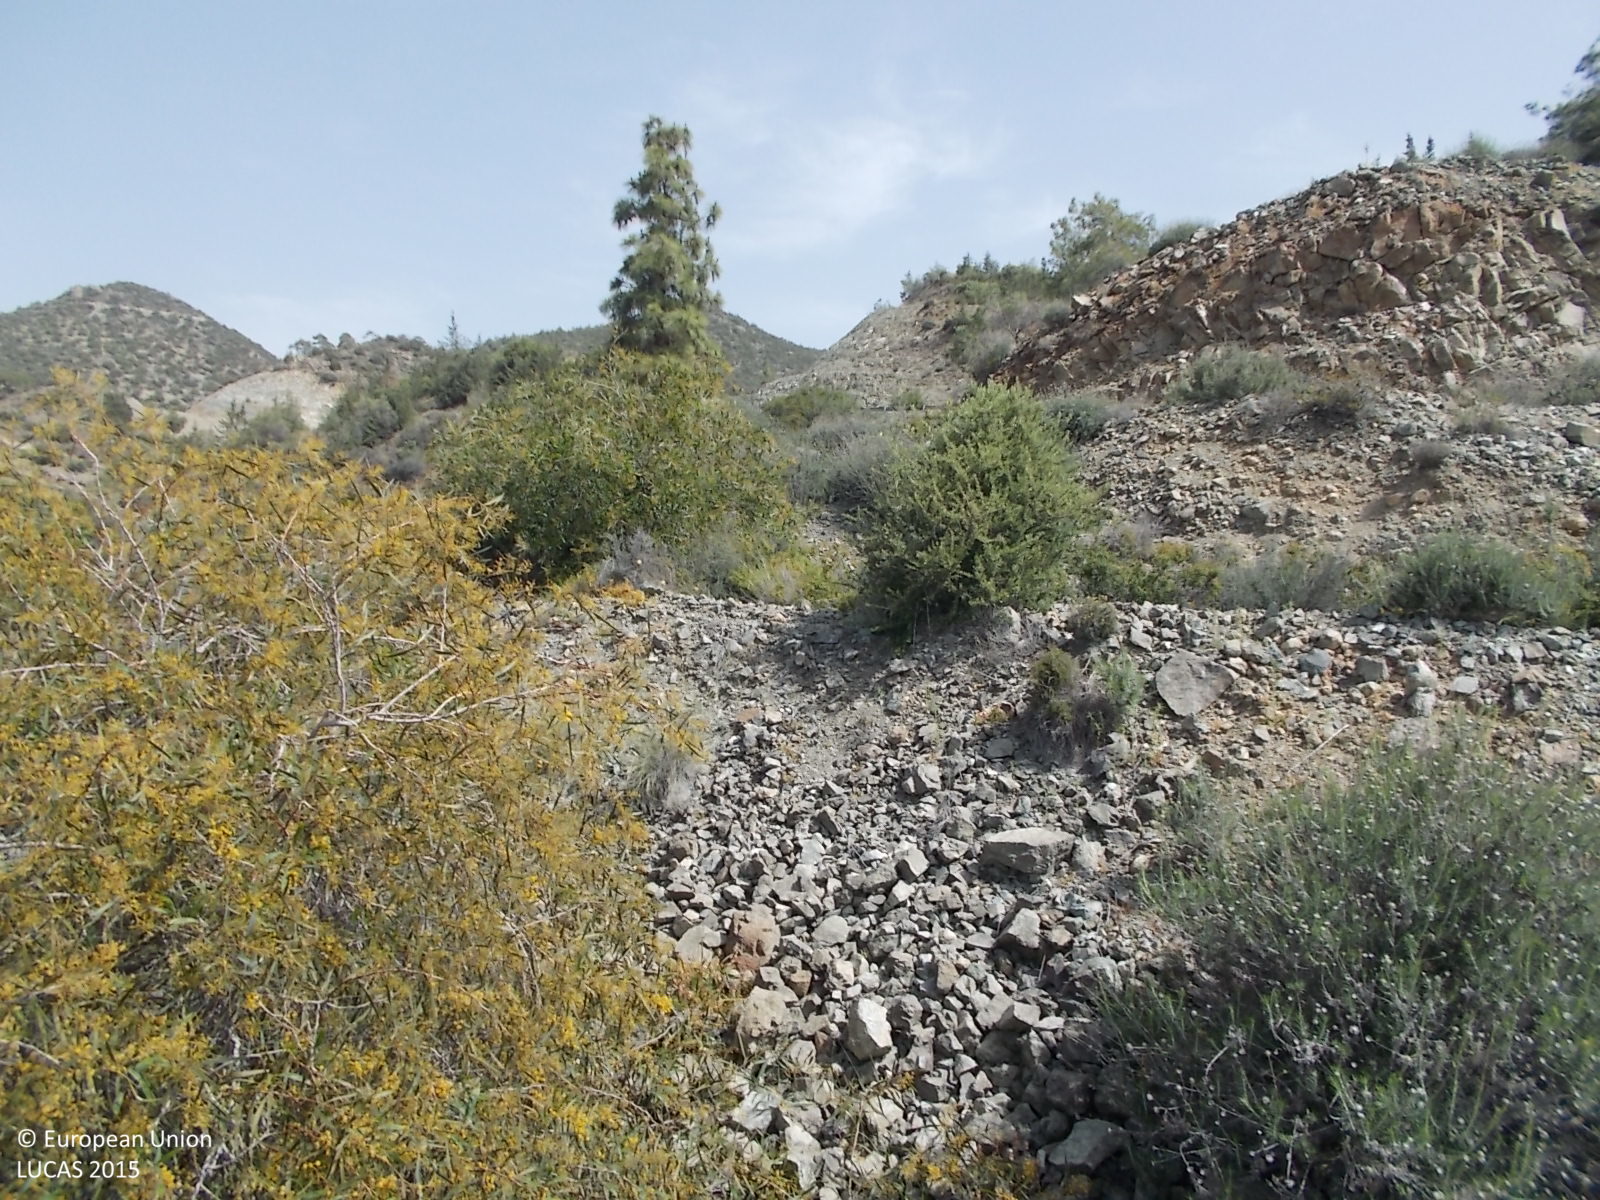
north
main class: Shrubland
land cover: Shrubland with sparse tree cover
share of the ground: > 75 %
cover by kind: shrubs 95 %, coniferous forest trees 5 %
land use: Semi-natural and natural areas not in use
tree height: > 5 m
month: April
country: CY
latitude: 34.7912
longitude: 33.1568
